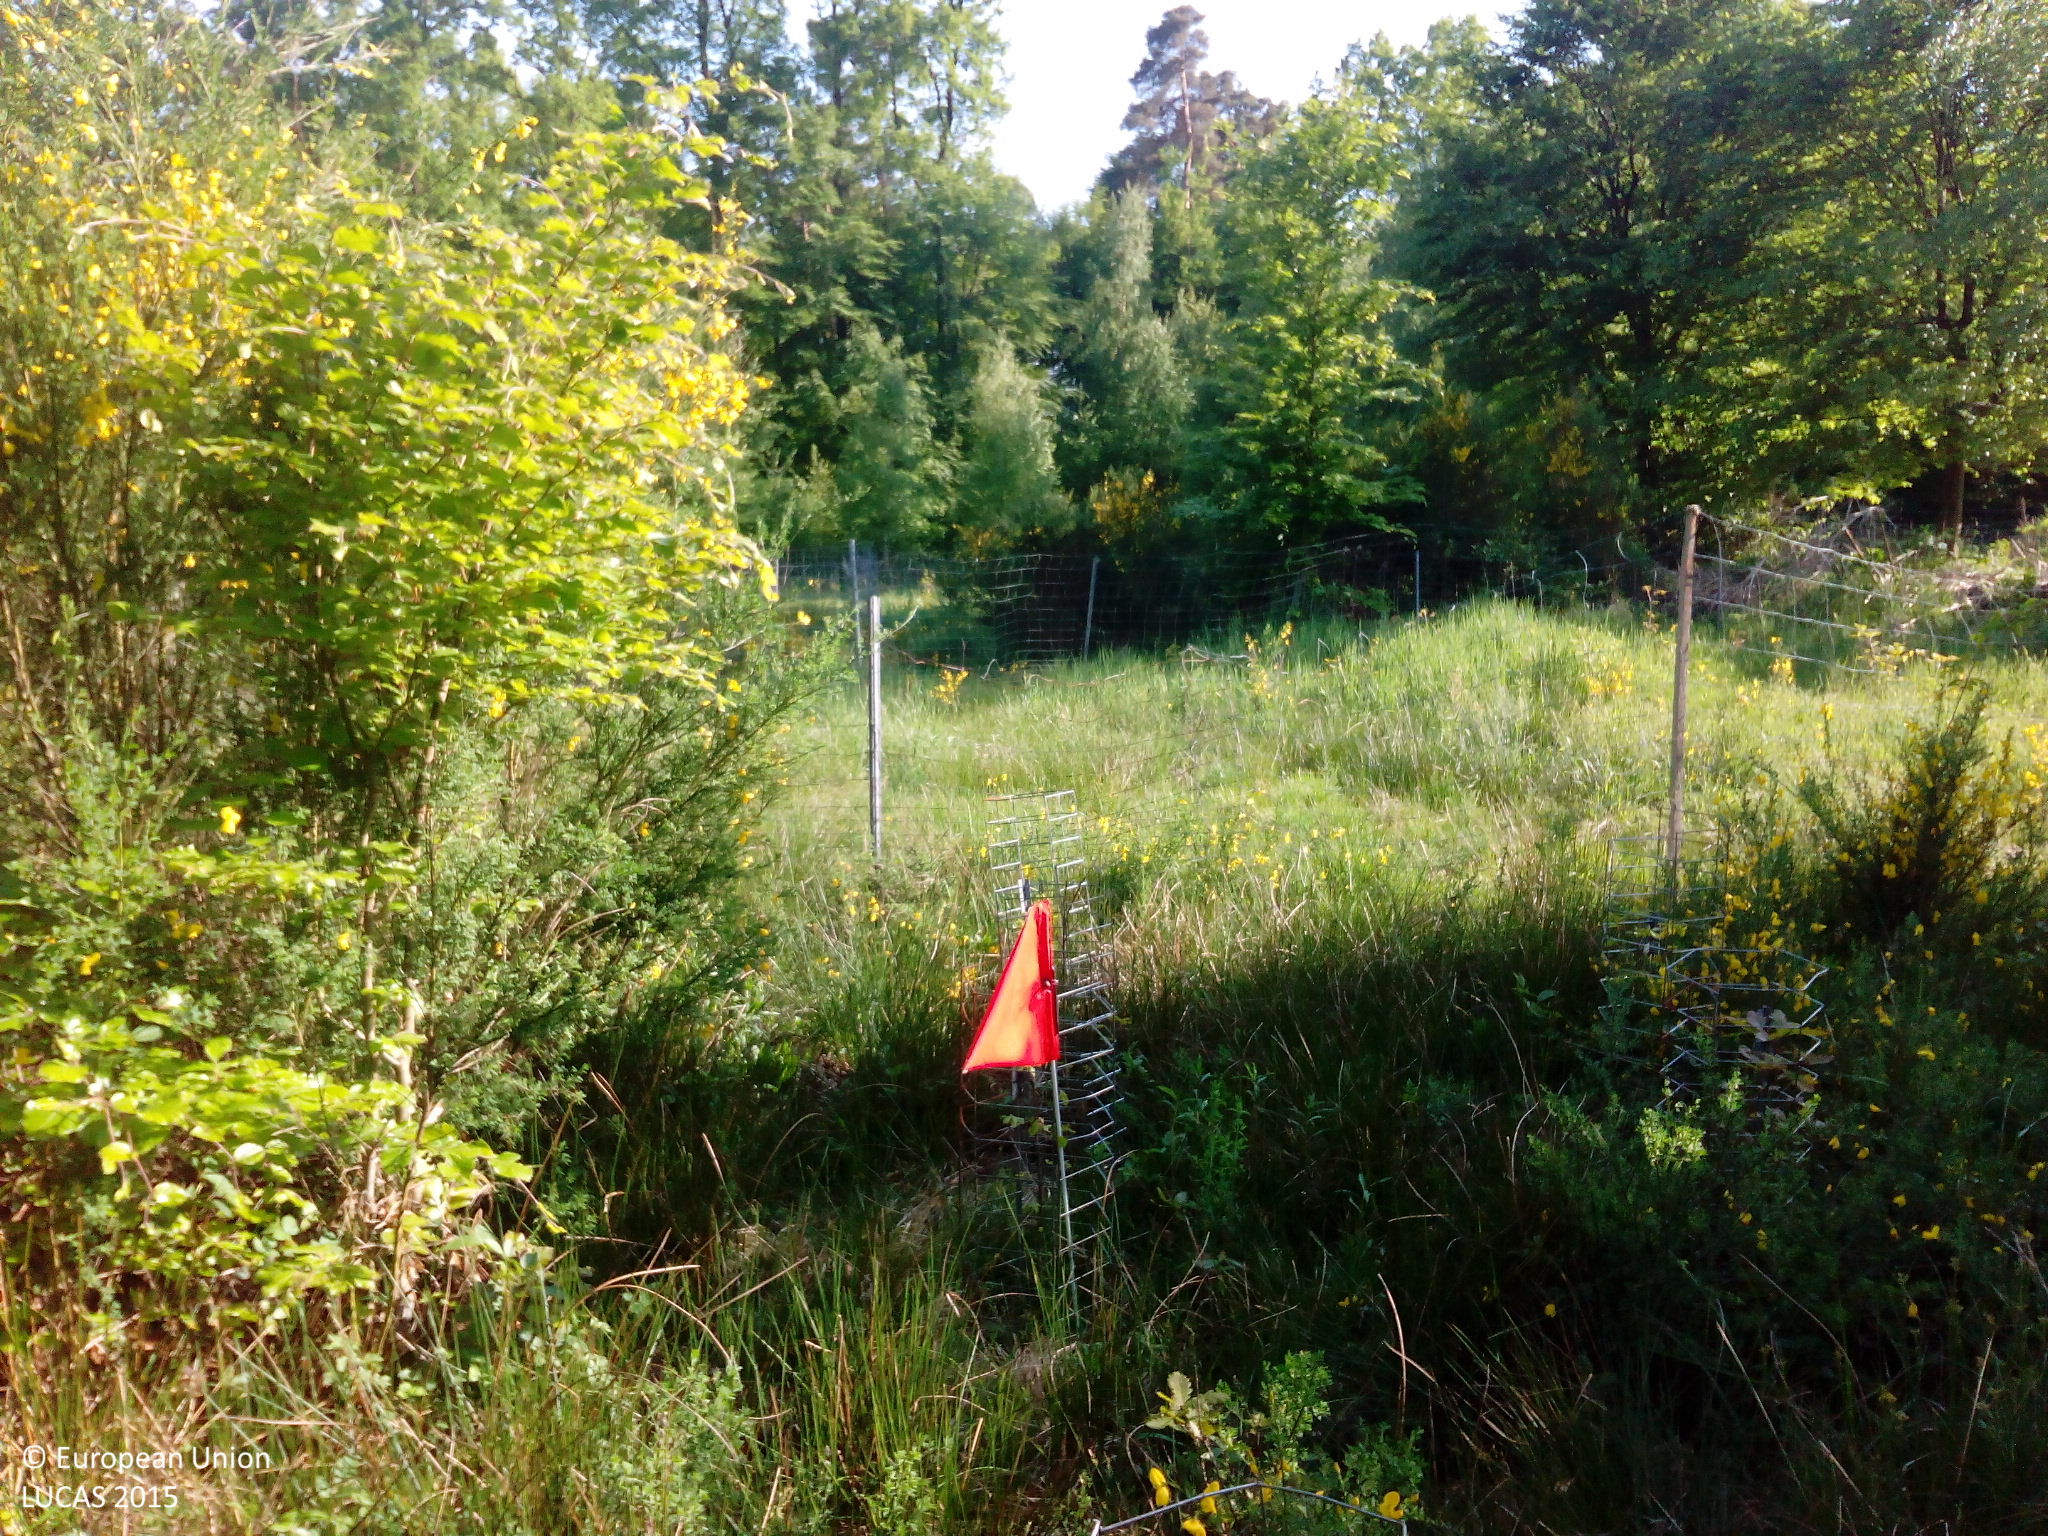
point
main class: Woodland
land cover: Broadleaved woodland
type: beech forest
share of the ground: 50 - 75 %
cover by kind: broadleaved forest trees 60 %, herbaceous plants 30 %, shrubs 5 %, unconsolidated bare surface 5 %
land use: Forestry
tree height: > 5 m
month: May
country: DE
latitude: 48.9820
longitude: 8.1560
